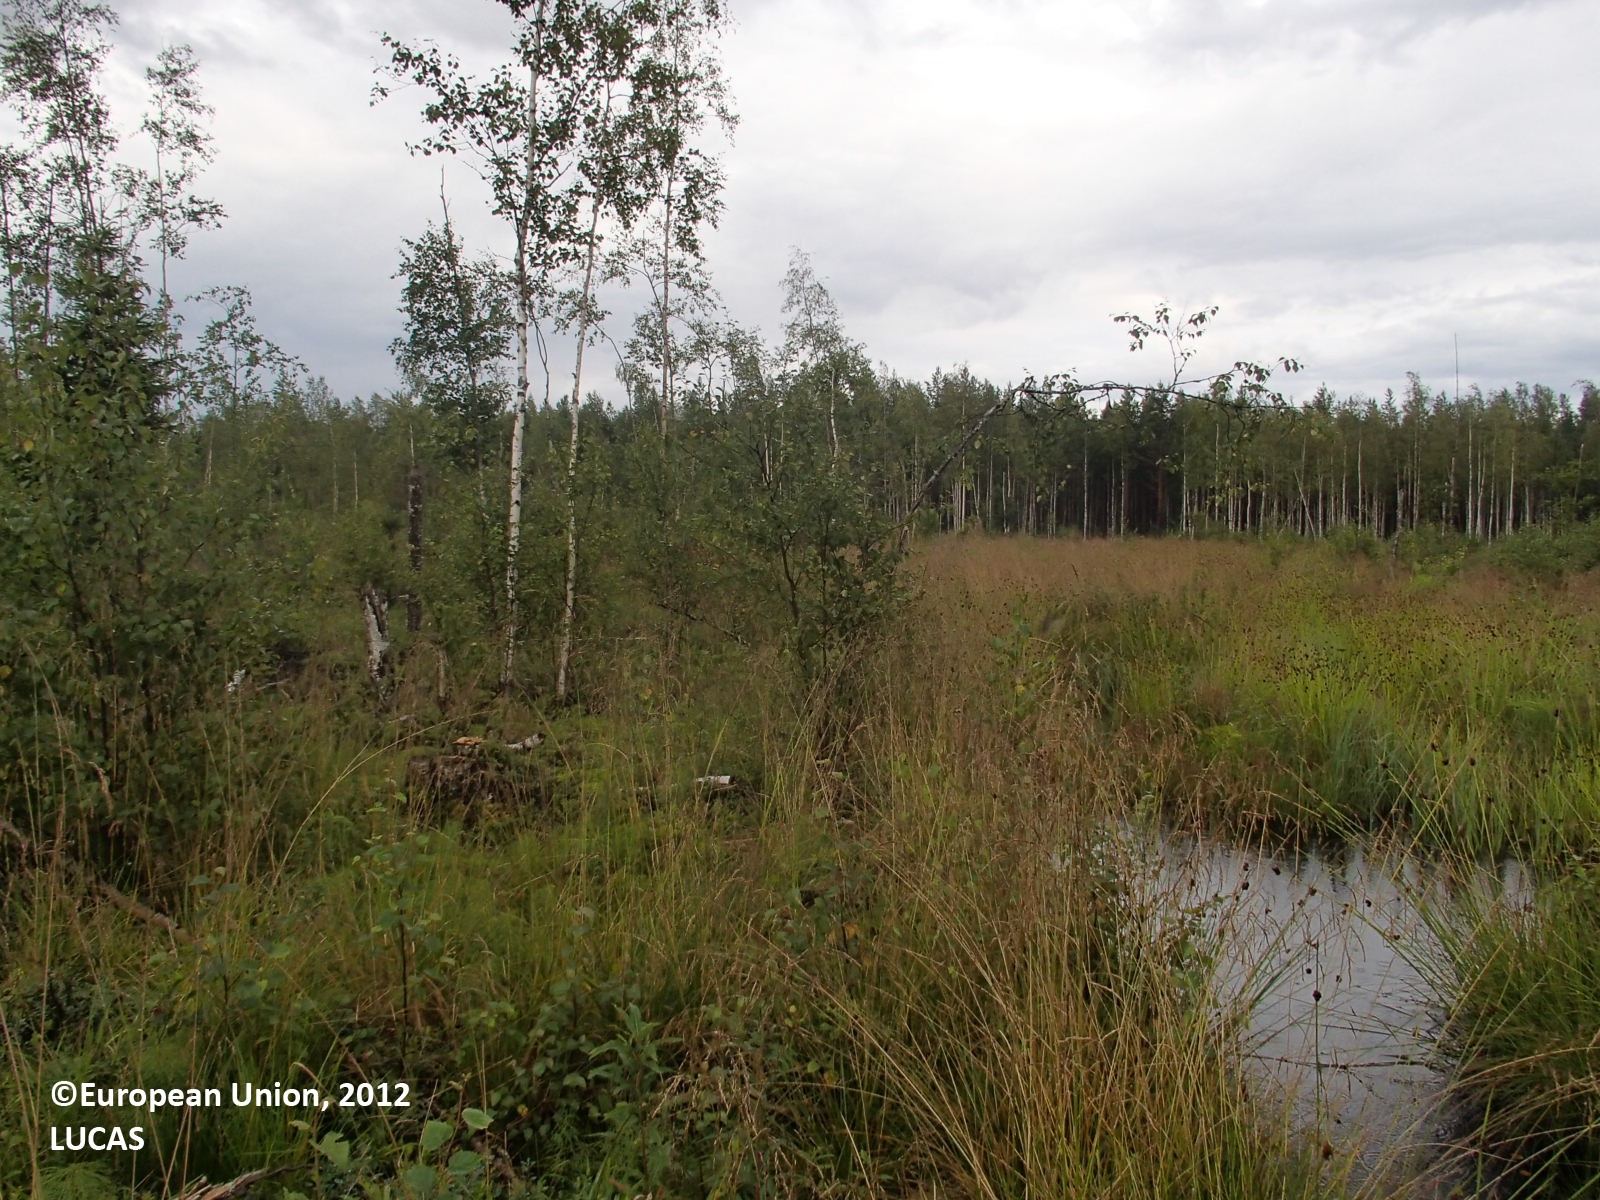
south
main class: Woodland
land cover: Spruce dominated mixed woodland
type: boreal forest
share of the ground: > 75 %
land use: Forestry
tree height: < 5 m
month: August
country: FI
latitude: 64.1144
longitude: 26.1859
